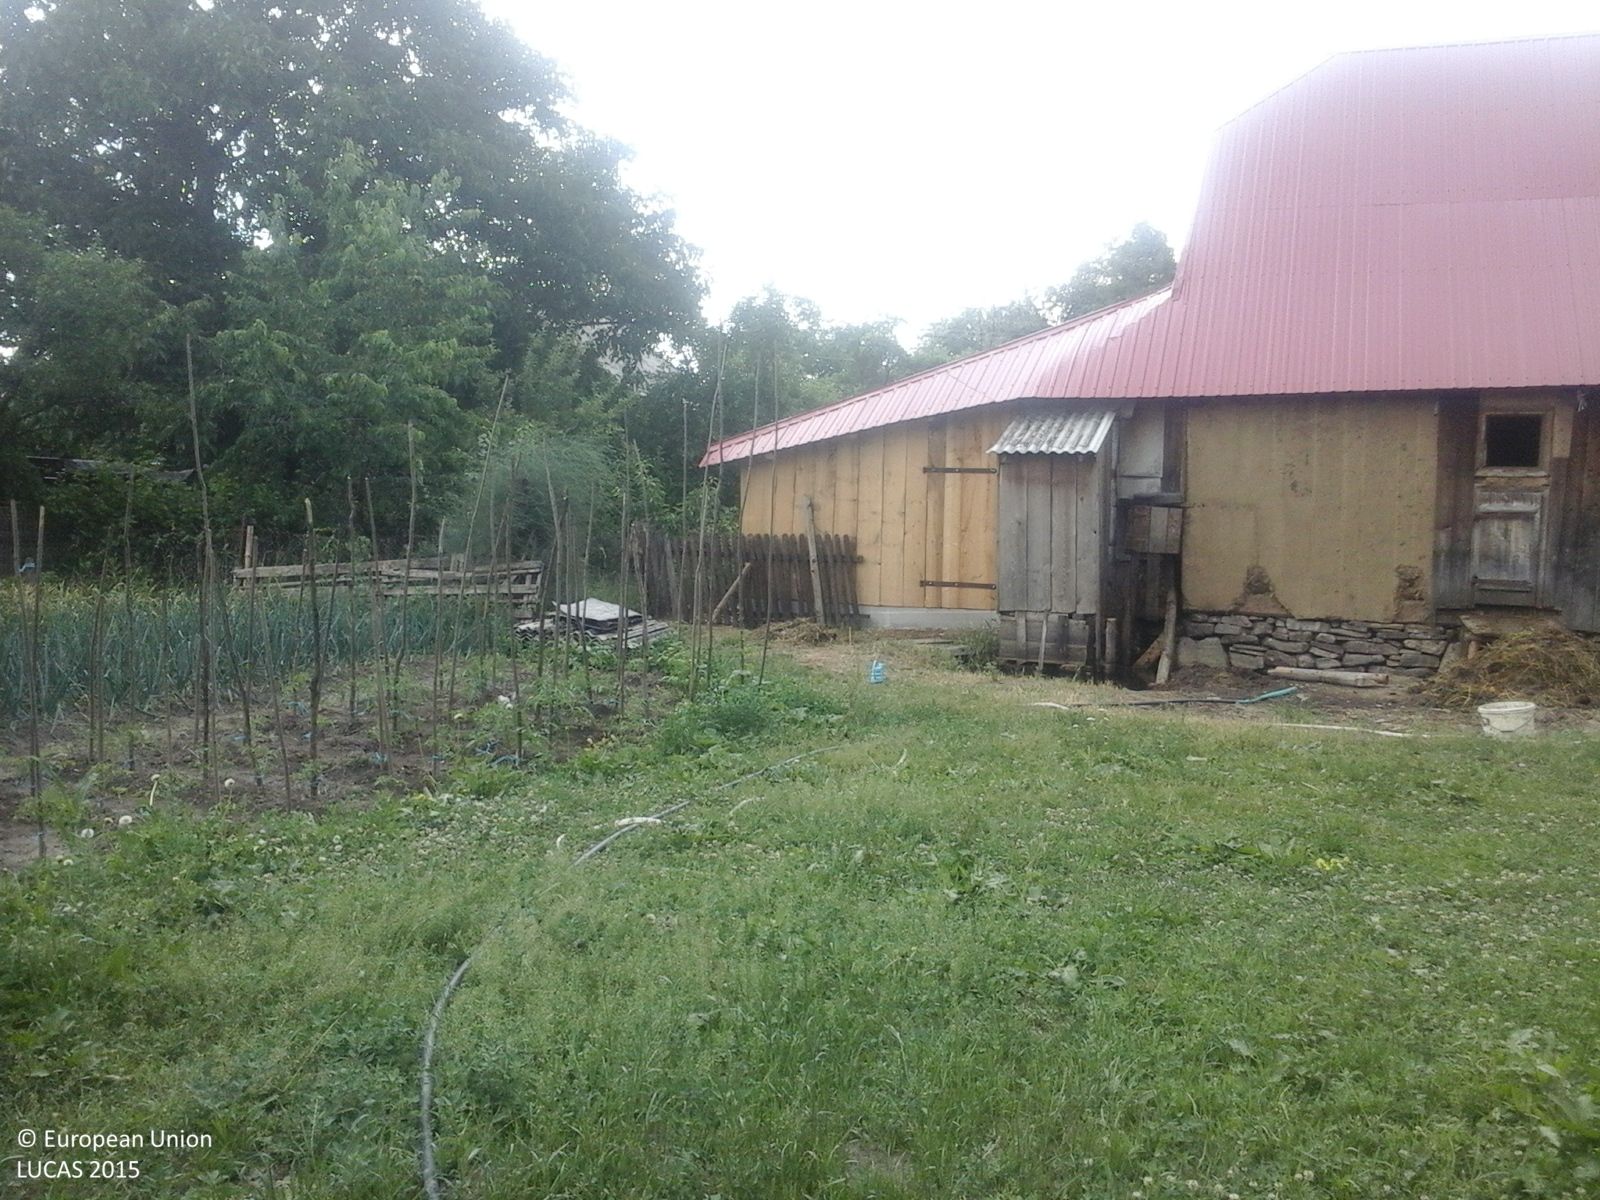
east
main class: Grassland
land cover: Grassland without tree/shrub cover
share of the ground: 50 - 75 %
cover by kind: herbaceous plants 100 %
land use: Agriculture (excluding fallow land and kitchen gardens)
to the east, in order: Grassland without tree/shrub cover; Artificial constructions in urban areas; Potatoes; Lucerne; Lines of trees; Grassland without tree/shrub cover; Electric lines; Grassland without tree/shrub cover; Broadleaved woodland; Ditches and canals; Broadleaved woodland
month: June
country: RO
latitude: 47.6425
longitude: 25.9281
